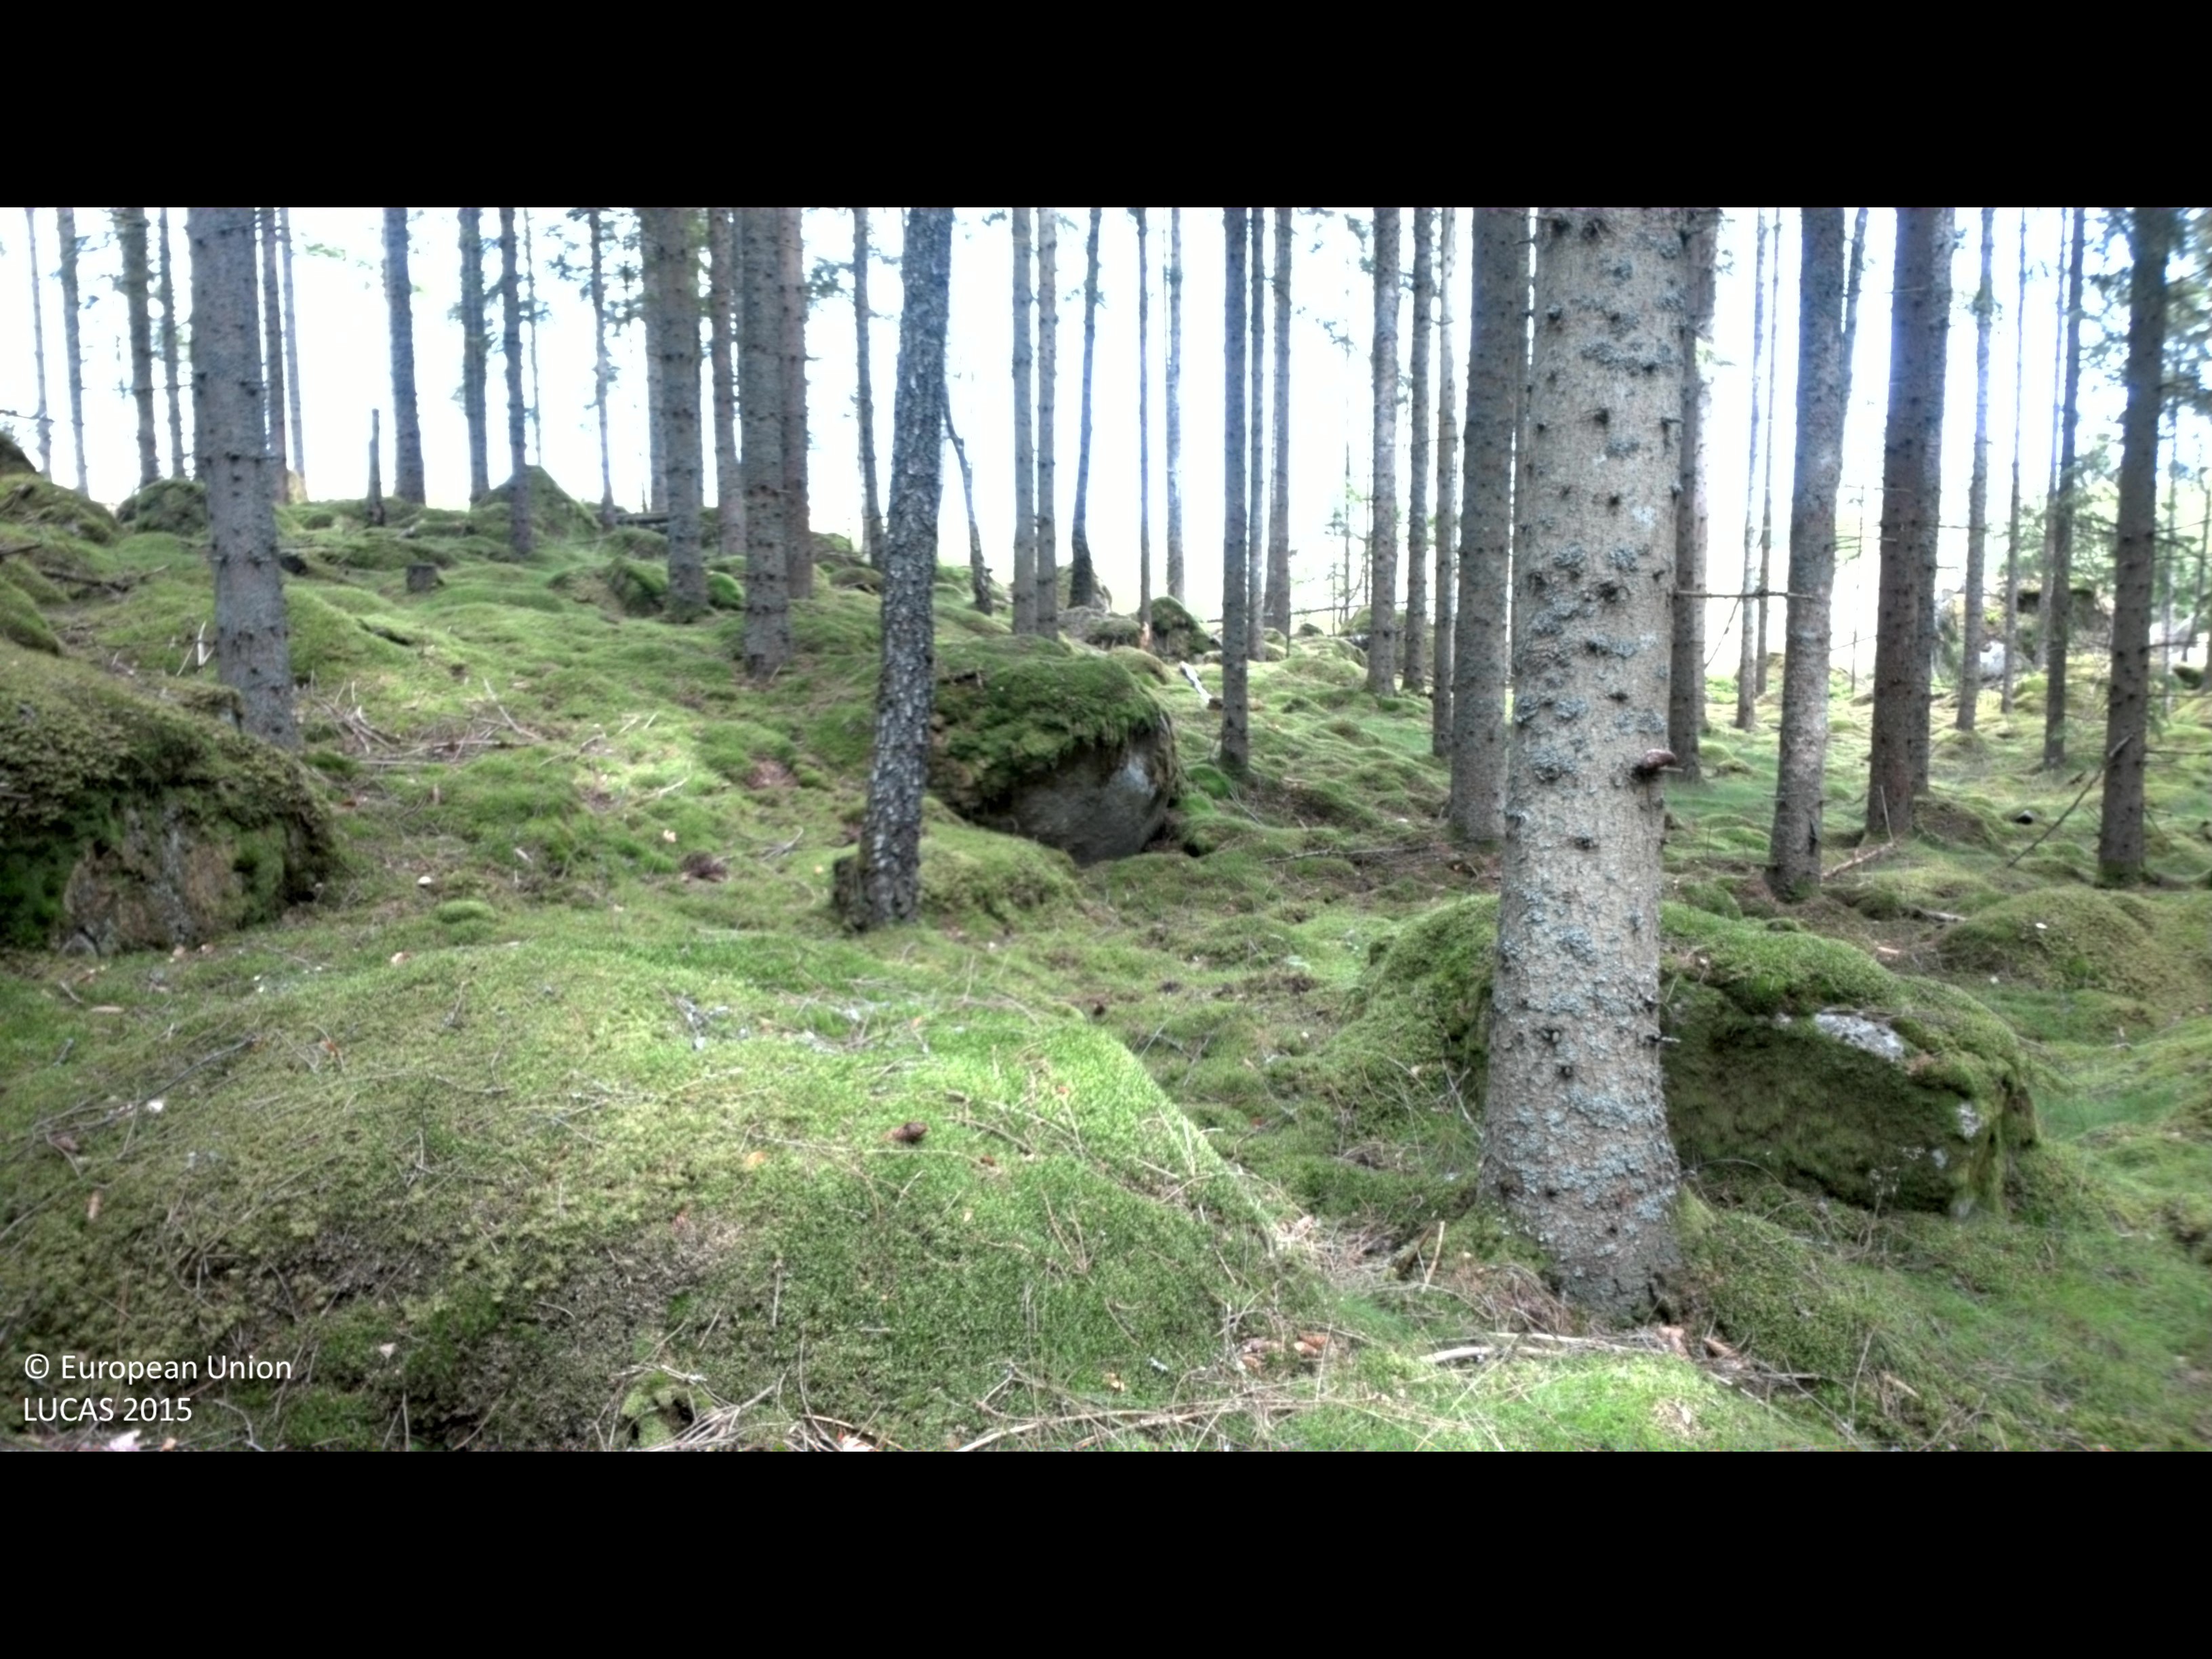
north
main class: Woodland
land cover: Spruce dominated coniferous woodland
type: boreal forest
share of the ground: > 75 %
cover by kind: coniferous forest trees 75 %, lichens and mosses 25 %
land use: Forestry
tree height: > 5 m
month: August
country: SE
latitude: 56.4312
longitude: 14.5543
